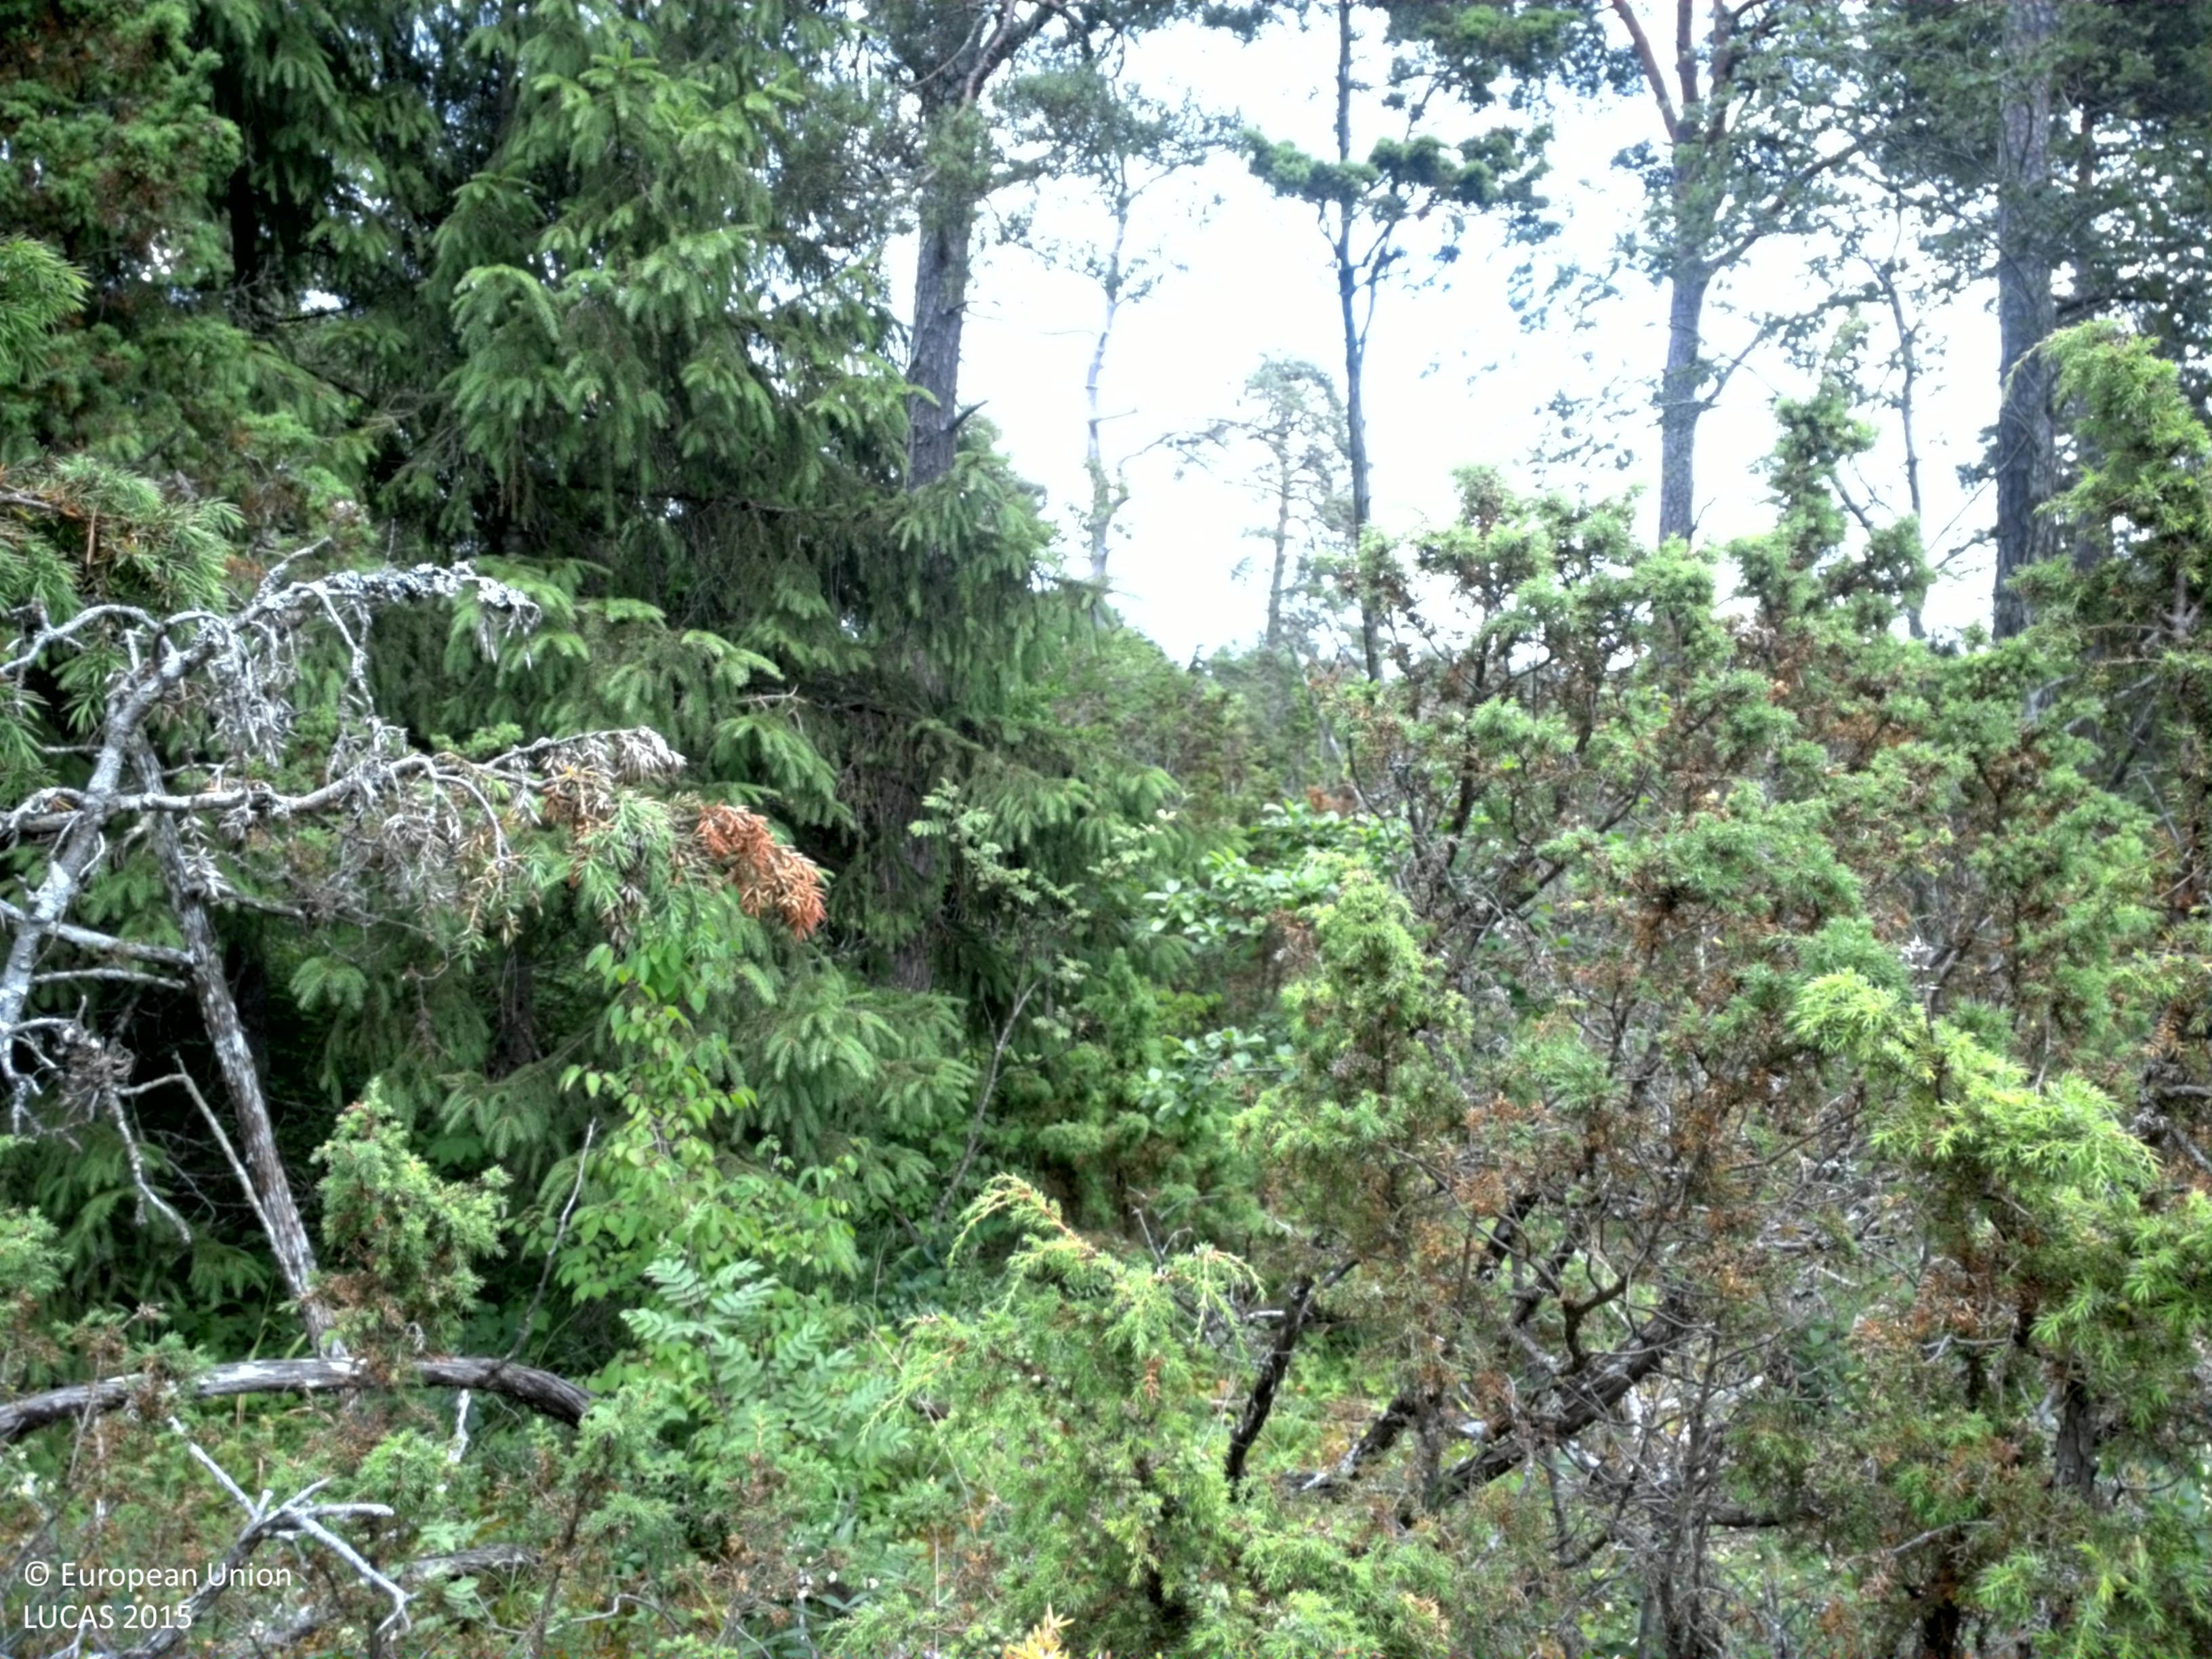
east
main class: Shrubland
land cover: Shrubland with sparse tree cover
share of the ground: > 75 %
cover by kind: shrubs 75 %, herbaceous plants 15 %, coniferous forest trees 5 %, lichens and mosses 5 %
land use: Semi-natural and natural areas not in use
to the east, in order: Shrubland with sparse tree cover; Pine dominated coniferous woodland; Shrubland with sparse tree cover; Tracks; Other bare soil; Shrubland with sparse tree cover; Tracks; Spontaneously vegetated surfaces; Other bare soil; Tracks; Shrubland with sparse tree cover; Pine dominated coniferous woodland
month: July
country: SE
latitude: 57.4245
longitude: 18.7869
